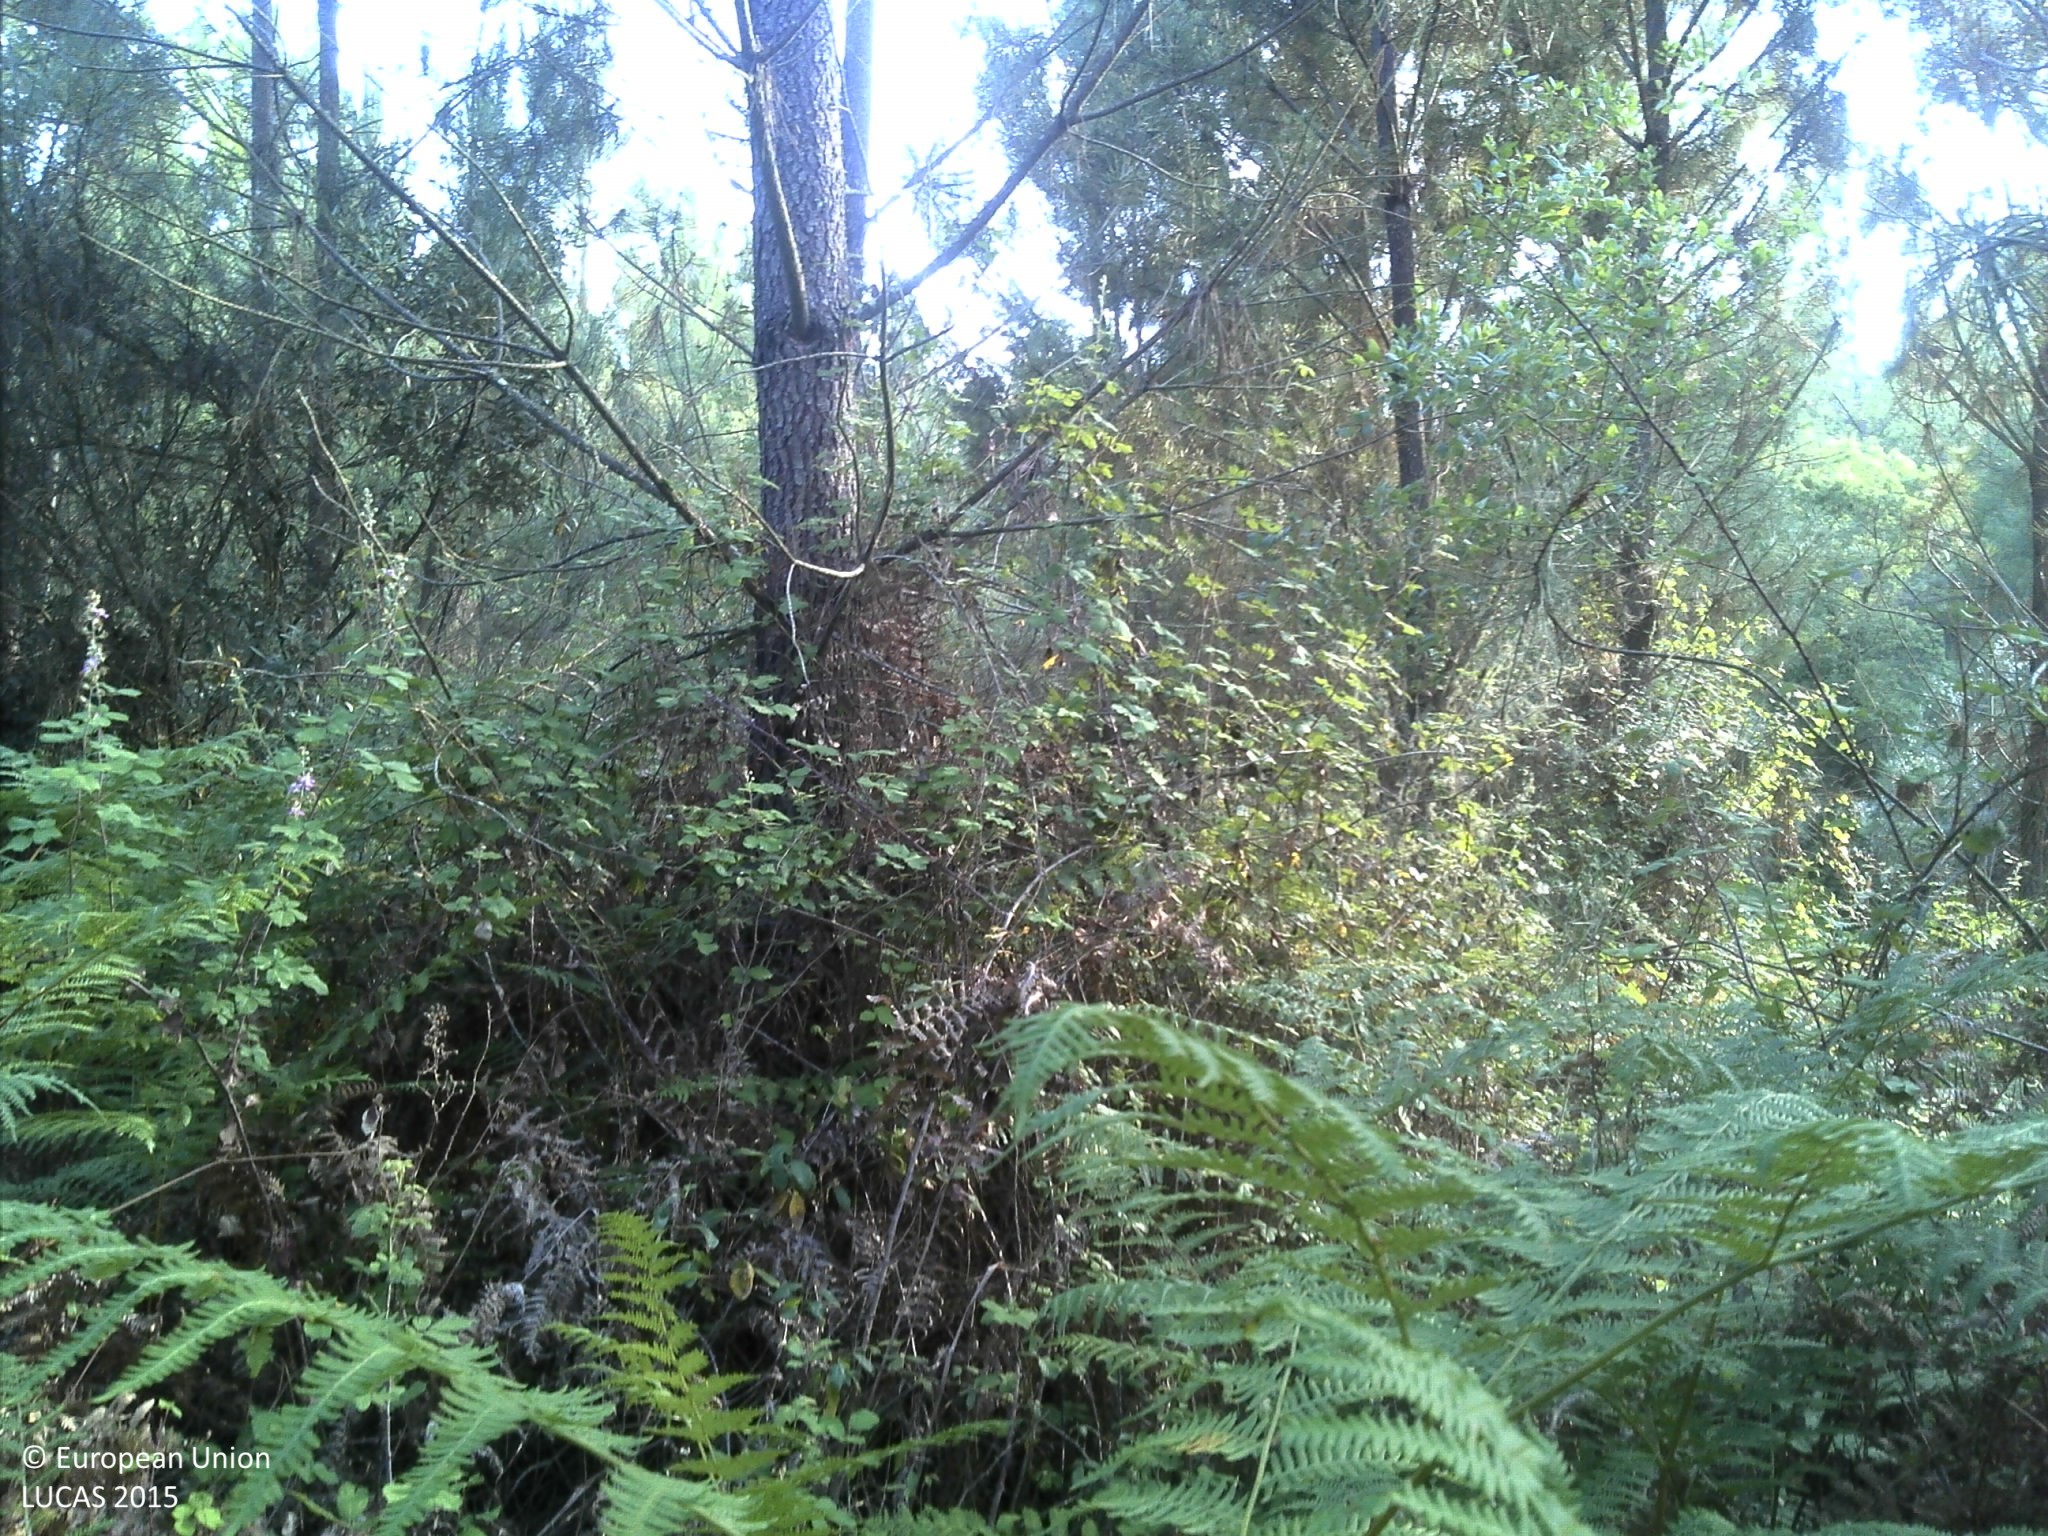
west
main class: Woodland
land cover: Pine dominated mixed woodland
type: coniferous forest of the mediterranean region
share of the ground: 25 - 50 %
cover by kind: coniferous forest trees 50 %, broadleaved forest trees 25 %, shrubs 20 %, unconsolidated bare surface 5 %
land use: Forestry
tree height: < 5 m
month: June
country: PT
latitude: 39.4308
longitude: -7.9356
